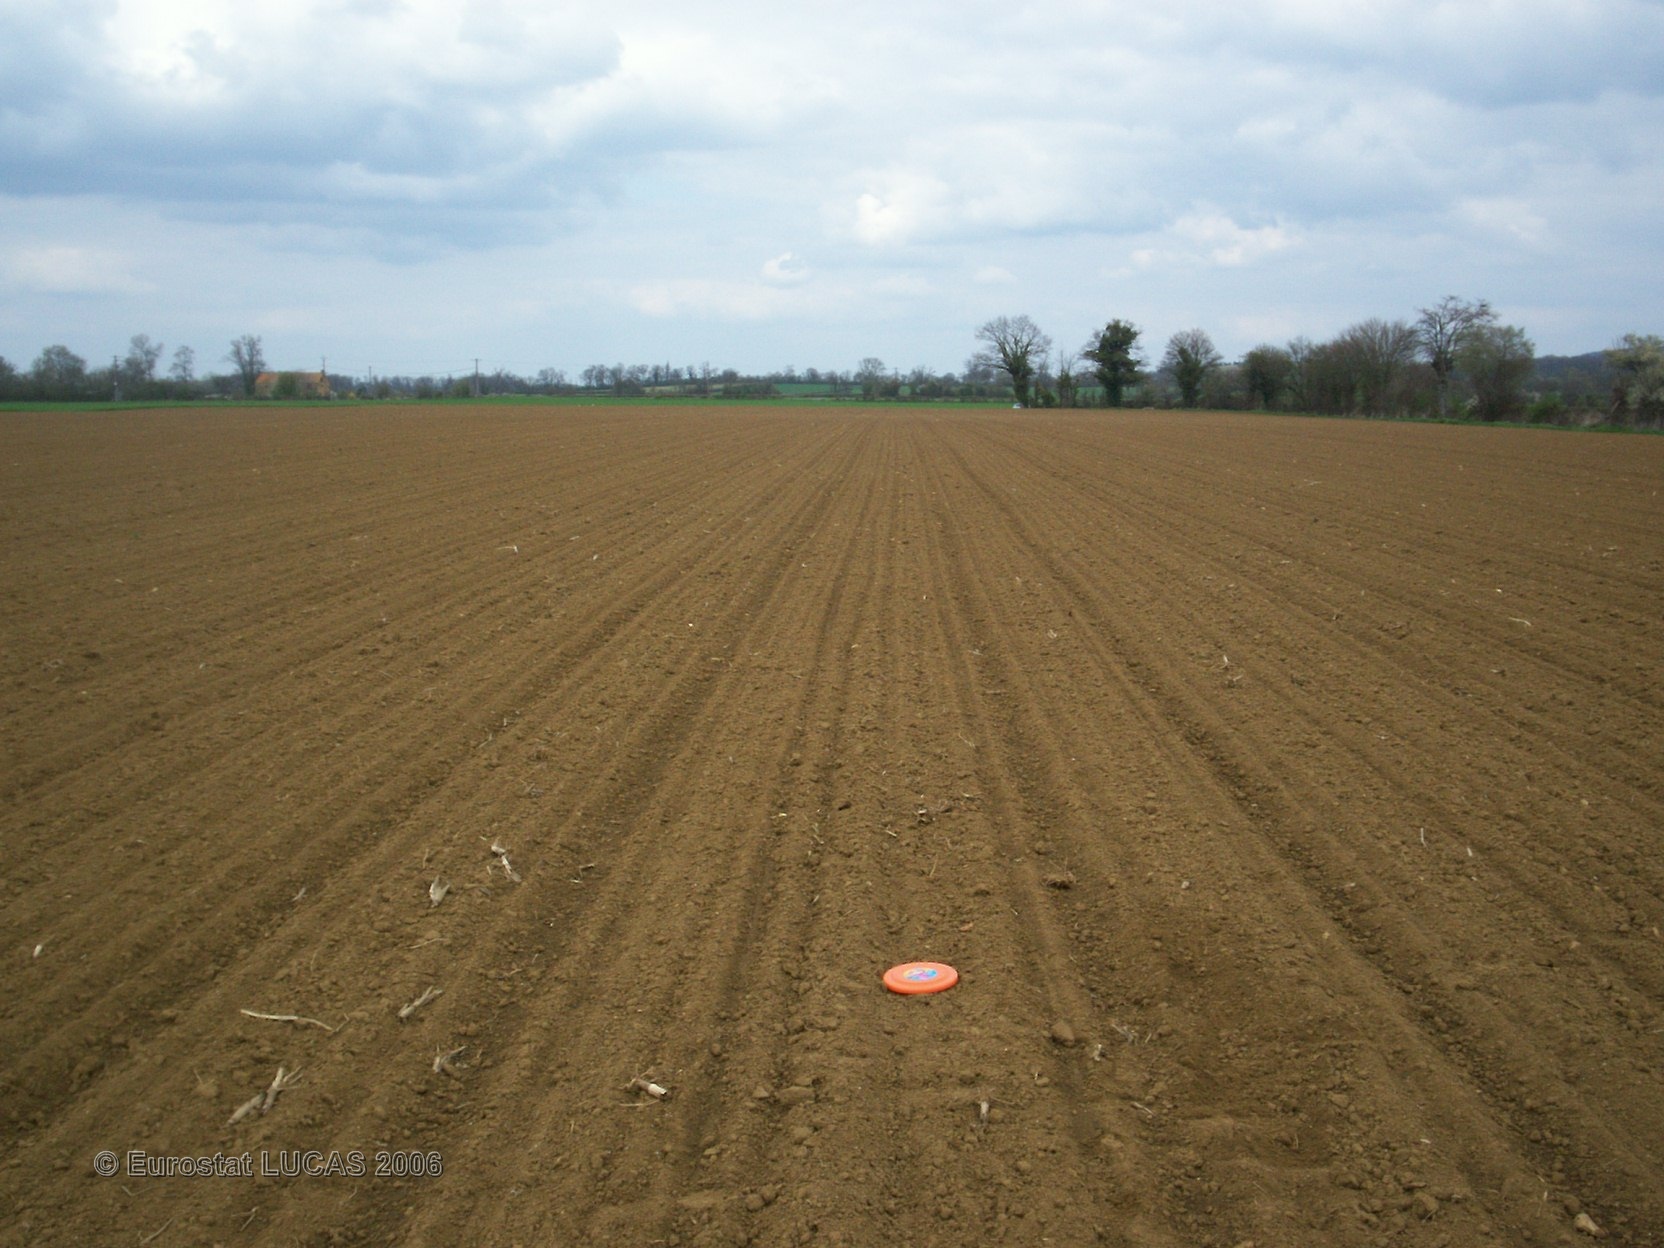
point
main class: Cropland
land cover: Sugar beet
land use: Agriculture (excluding fallow land and kitchen gardens)
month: April
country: FR
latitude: 48.9653
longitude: 0.0118
